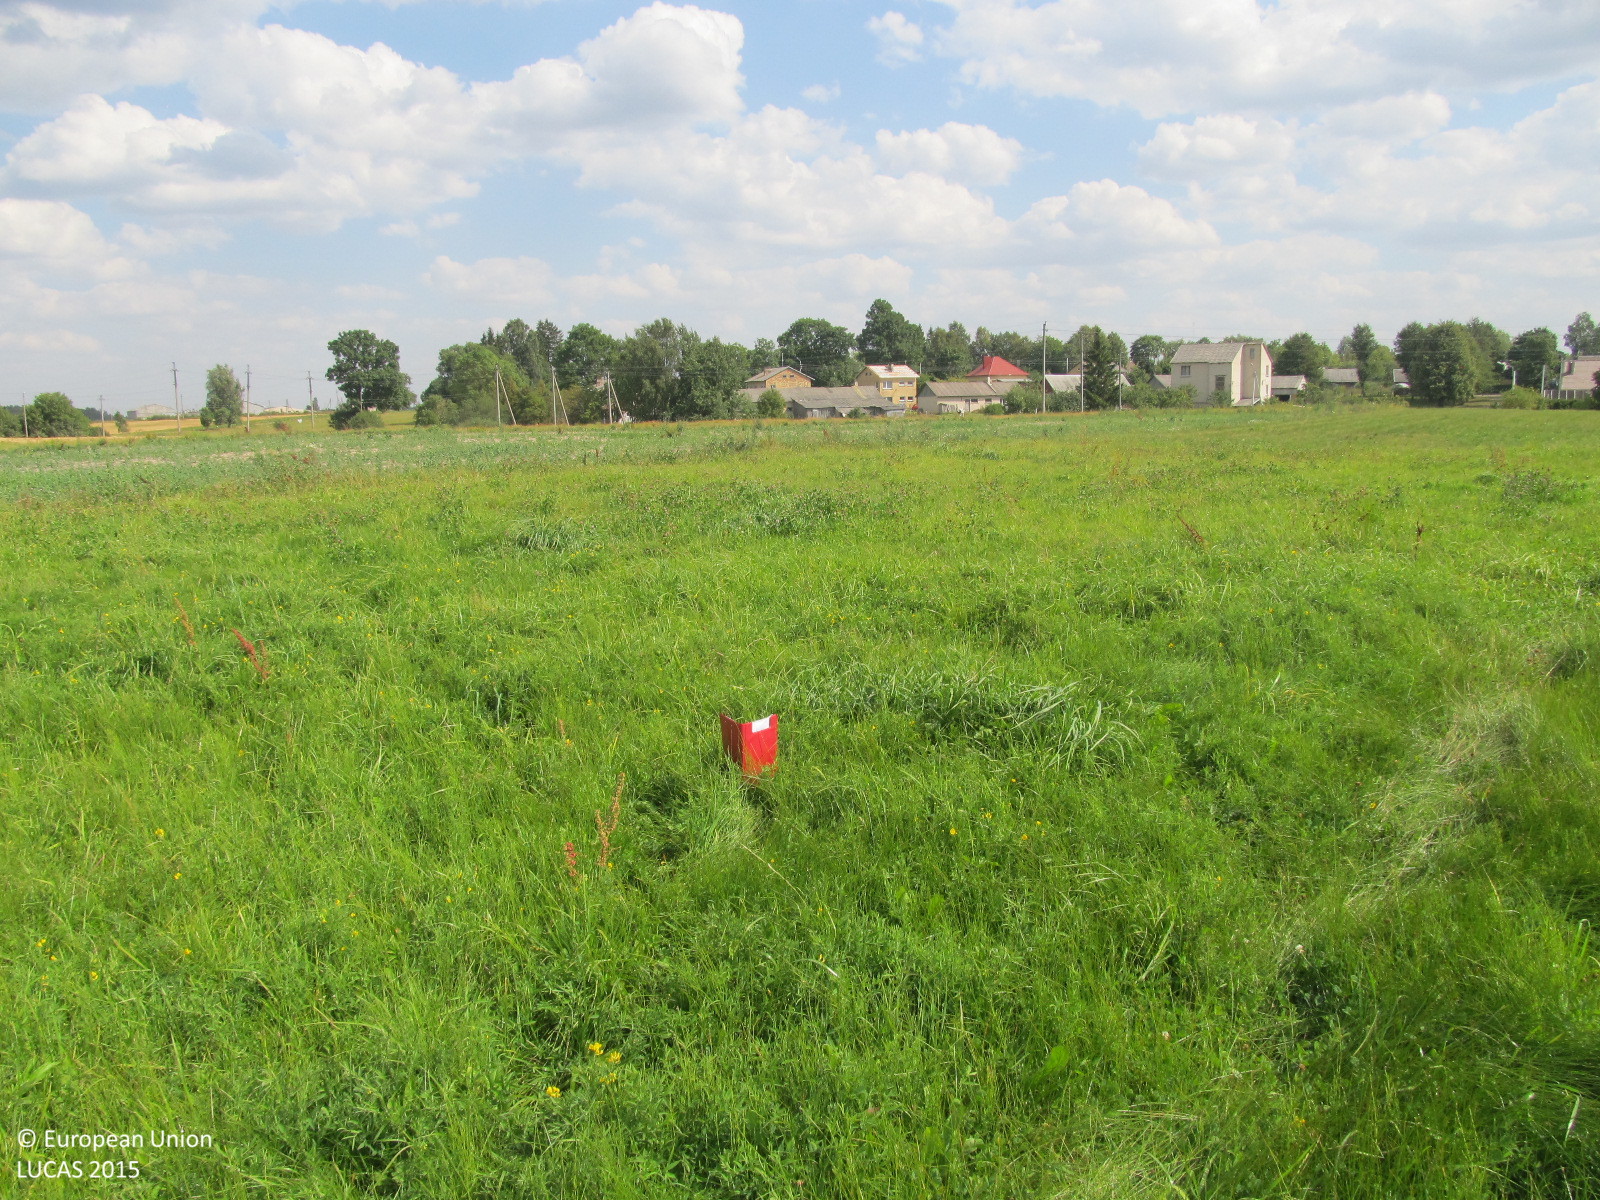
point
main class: Grassland
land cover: Grassland without tree/shrub cover
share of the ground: > 75 %
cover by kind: herbaceous plants 100 %
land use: Agriculture (excluding fallow land and kitchen gardens)
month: August
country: LT
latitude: 55.8005
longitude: 23.1362
